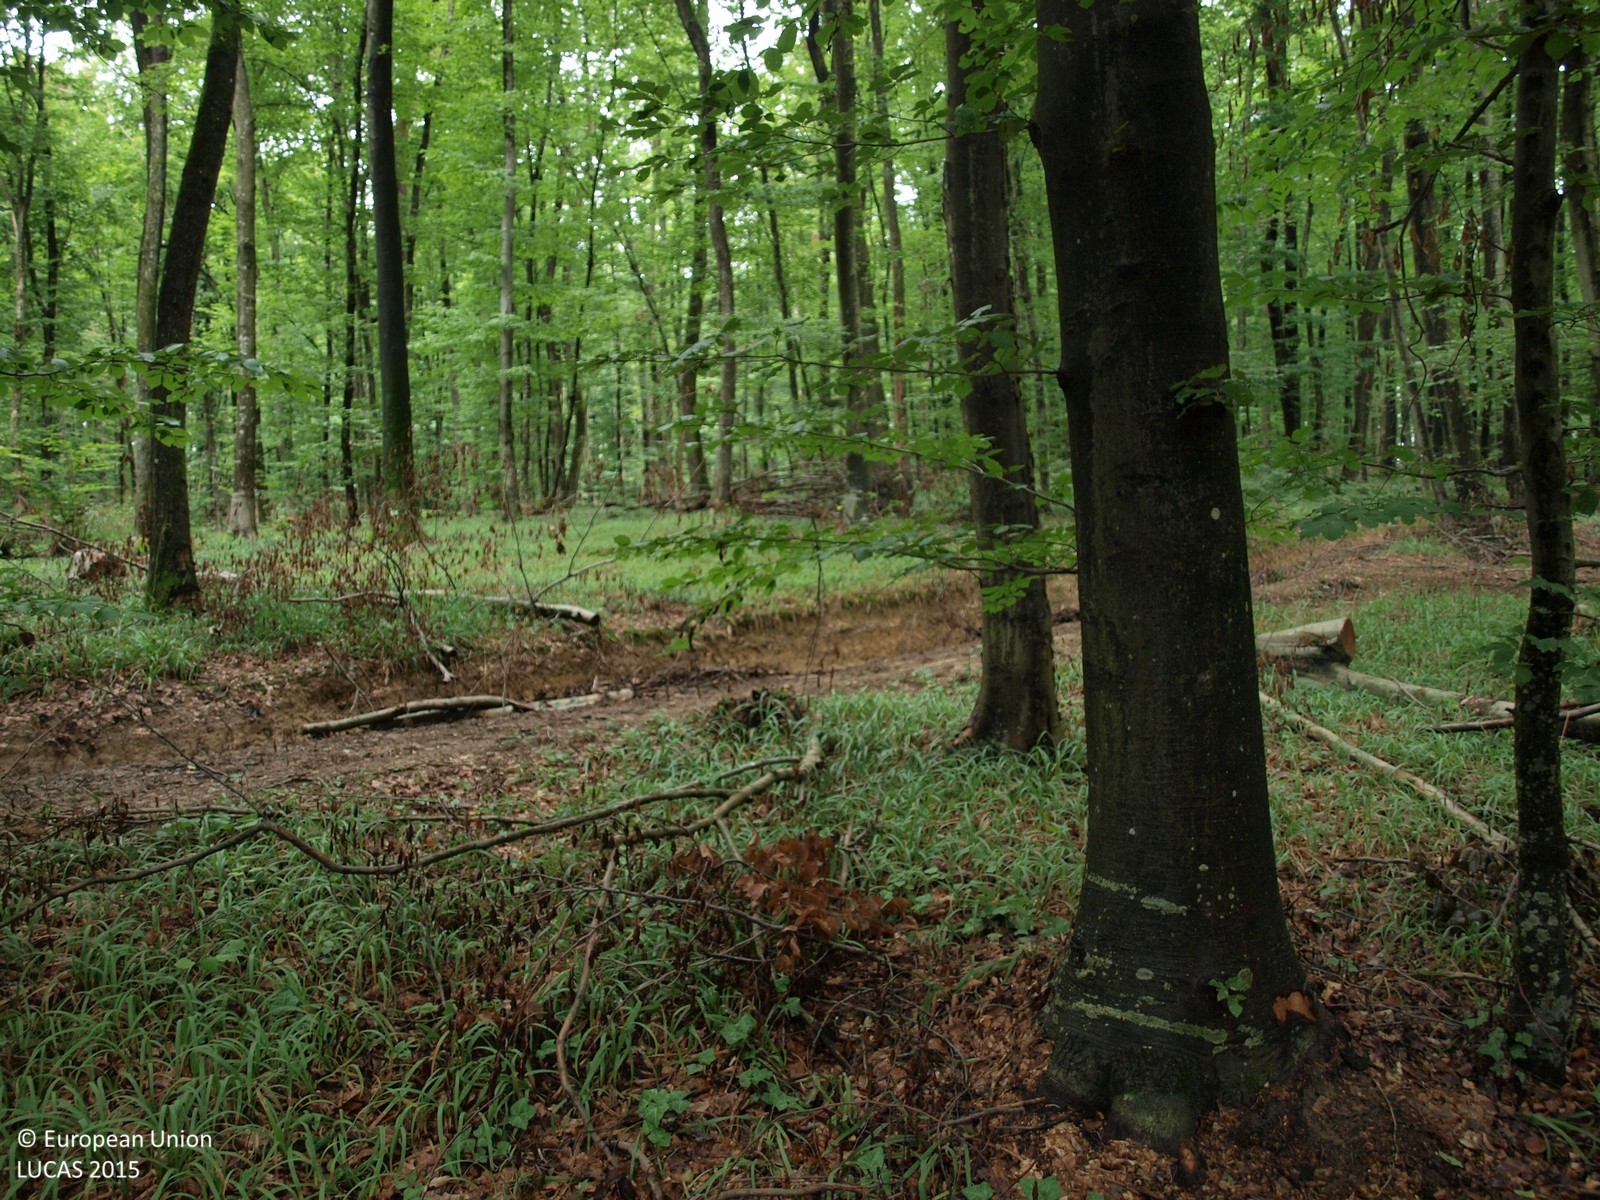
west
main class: Woodland
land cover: Broadleaved woodland
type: beech forest
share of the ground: > 75 %
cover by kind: broadleaved forest trees 100 %
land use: Forestry
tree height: > 5 m
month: July
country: HR
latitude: 46.0559
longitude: 16.3199
